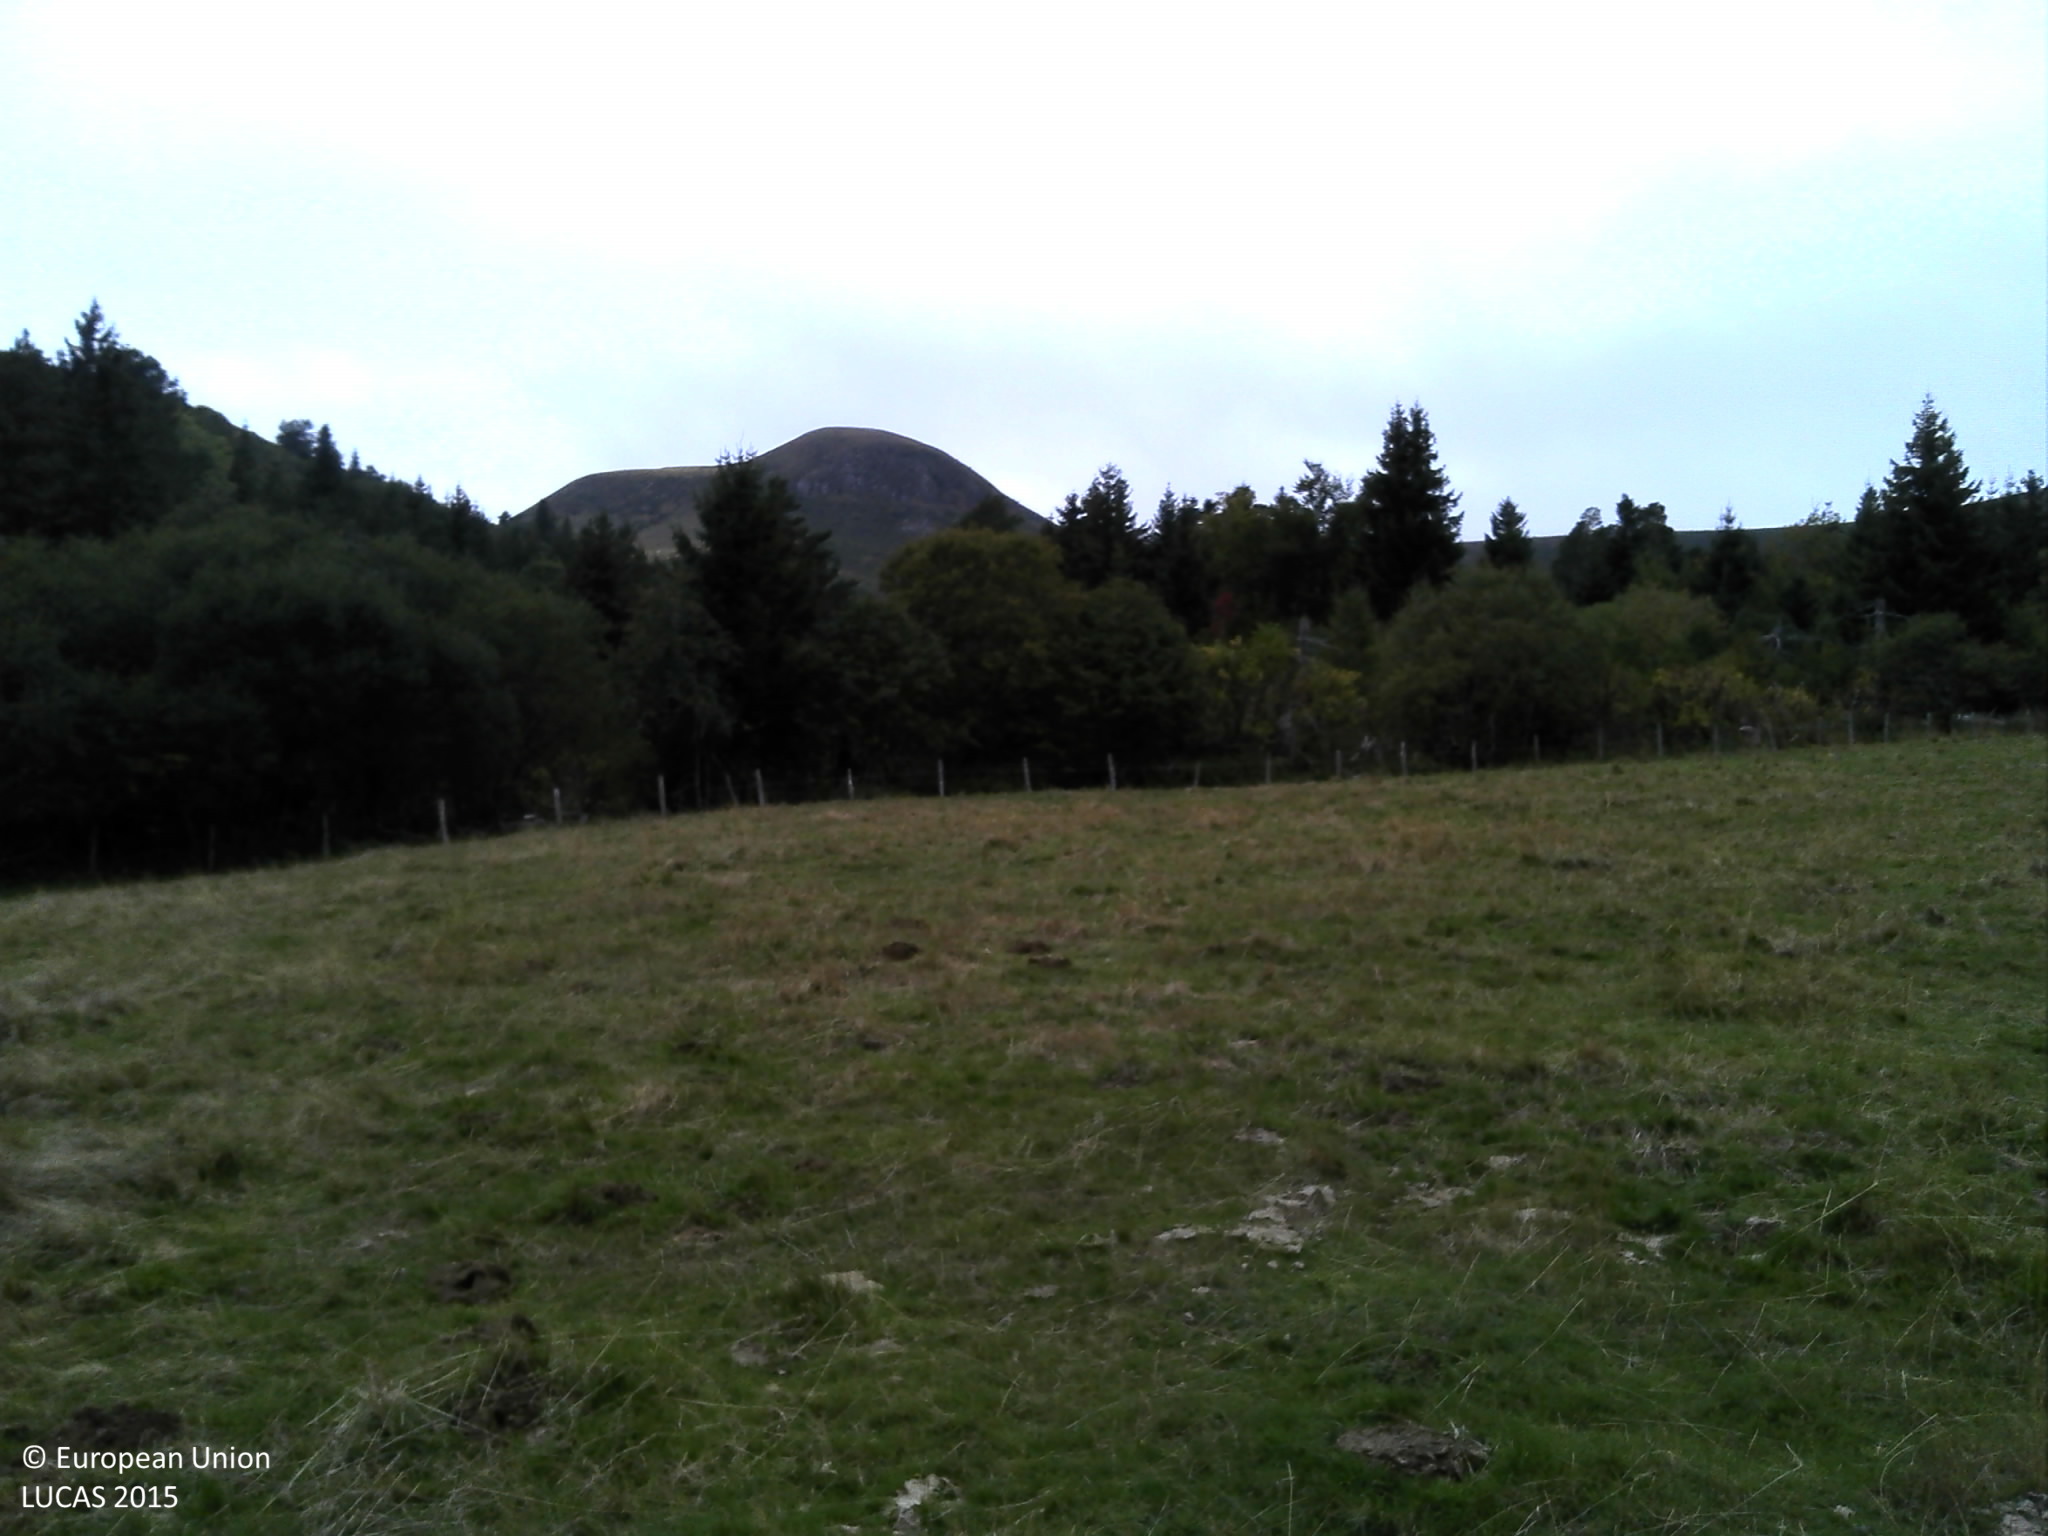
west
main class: Grassland
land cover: Grassland without tree/shrub cover
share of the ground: > 75 %
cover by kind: herbaceous plants 100 %
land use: Agriculture (excluding fallow land and kitchen gardens)
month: September
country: FR
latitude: 45.5898
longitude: 2.8856
